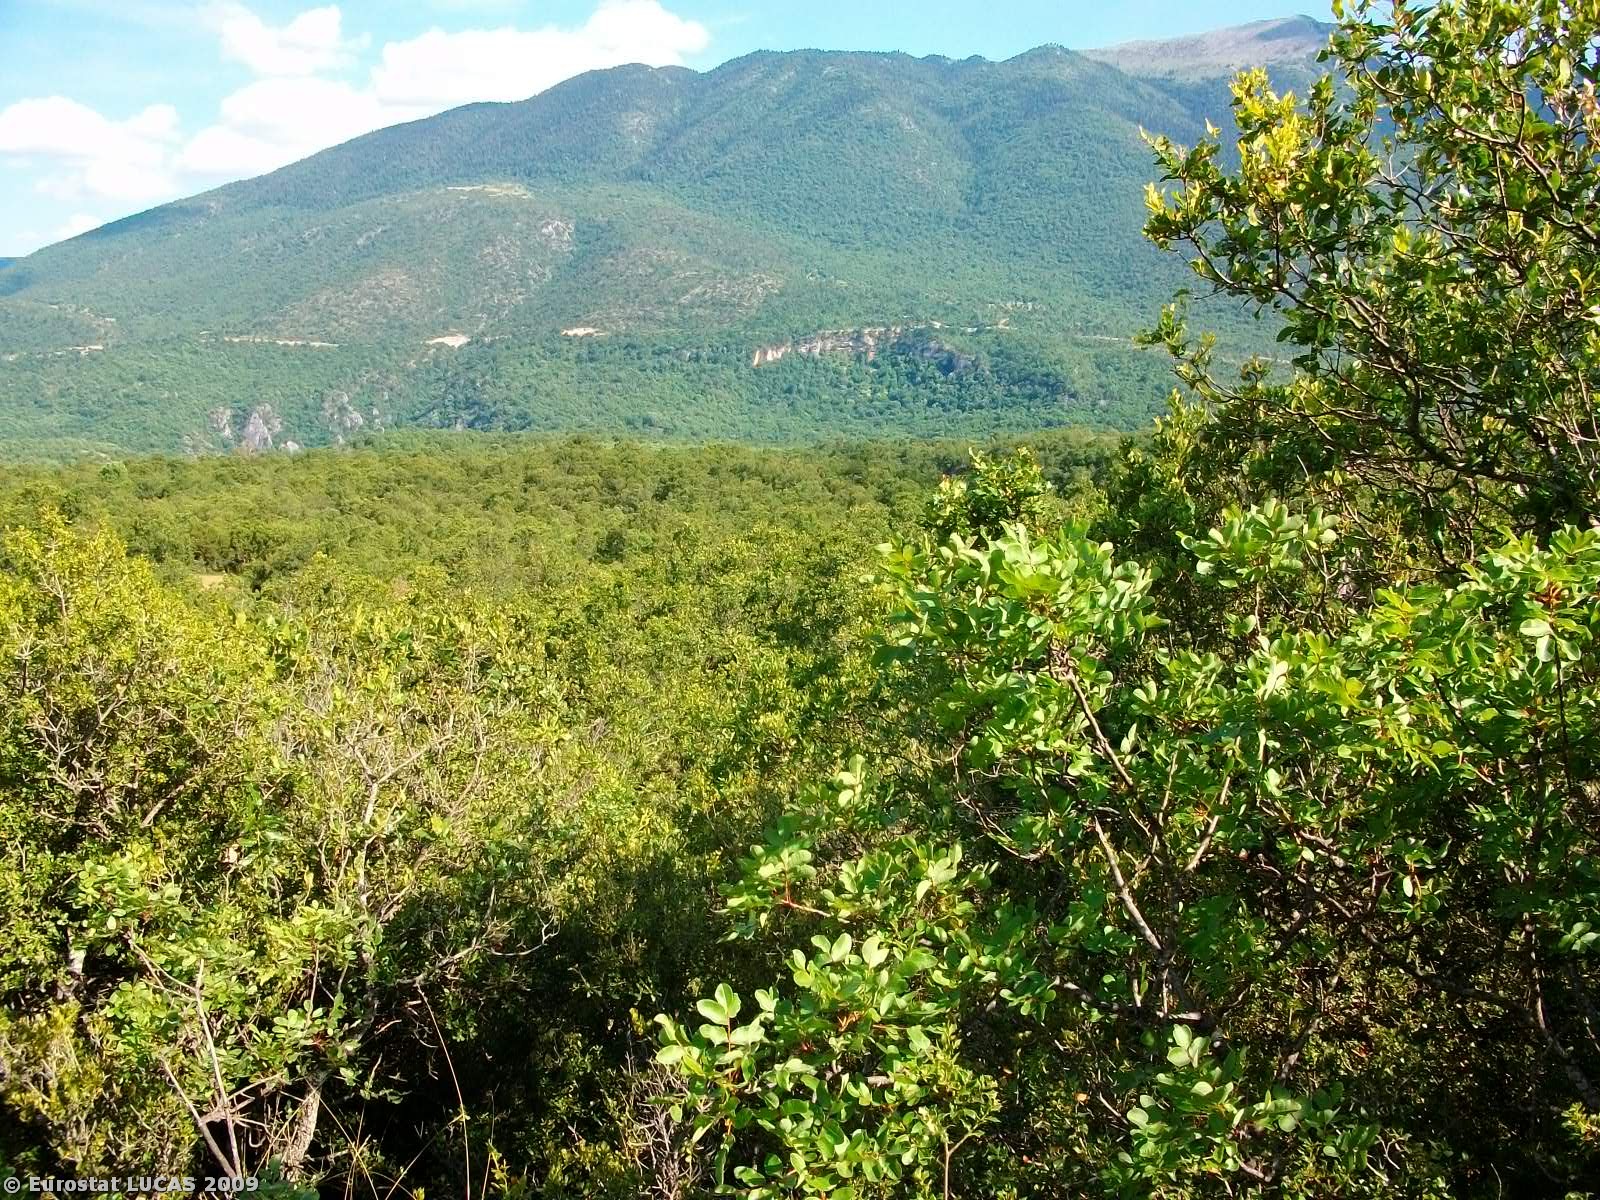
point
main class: Woodland
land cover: Broadleaved woodland
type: thermophilous deciduous forest
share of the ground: > 75 %
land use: Forestry
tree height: > 5 m
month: June
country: GR
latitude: 39.9959
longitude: 21.7594
